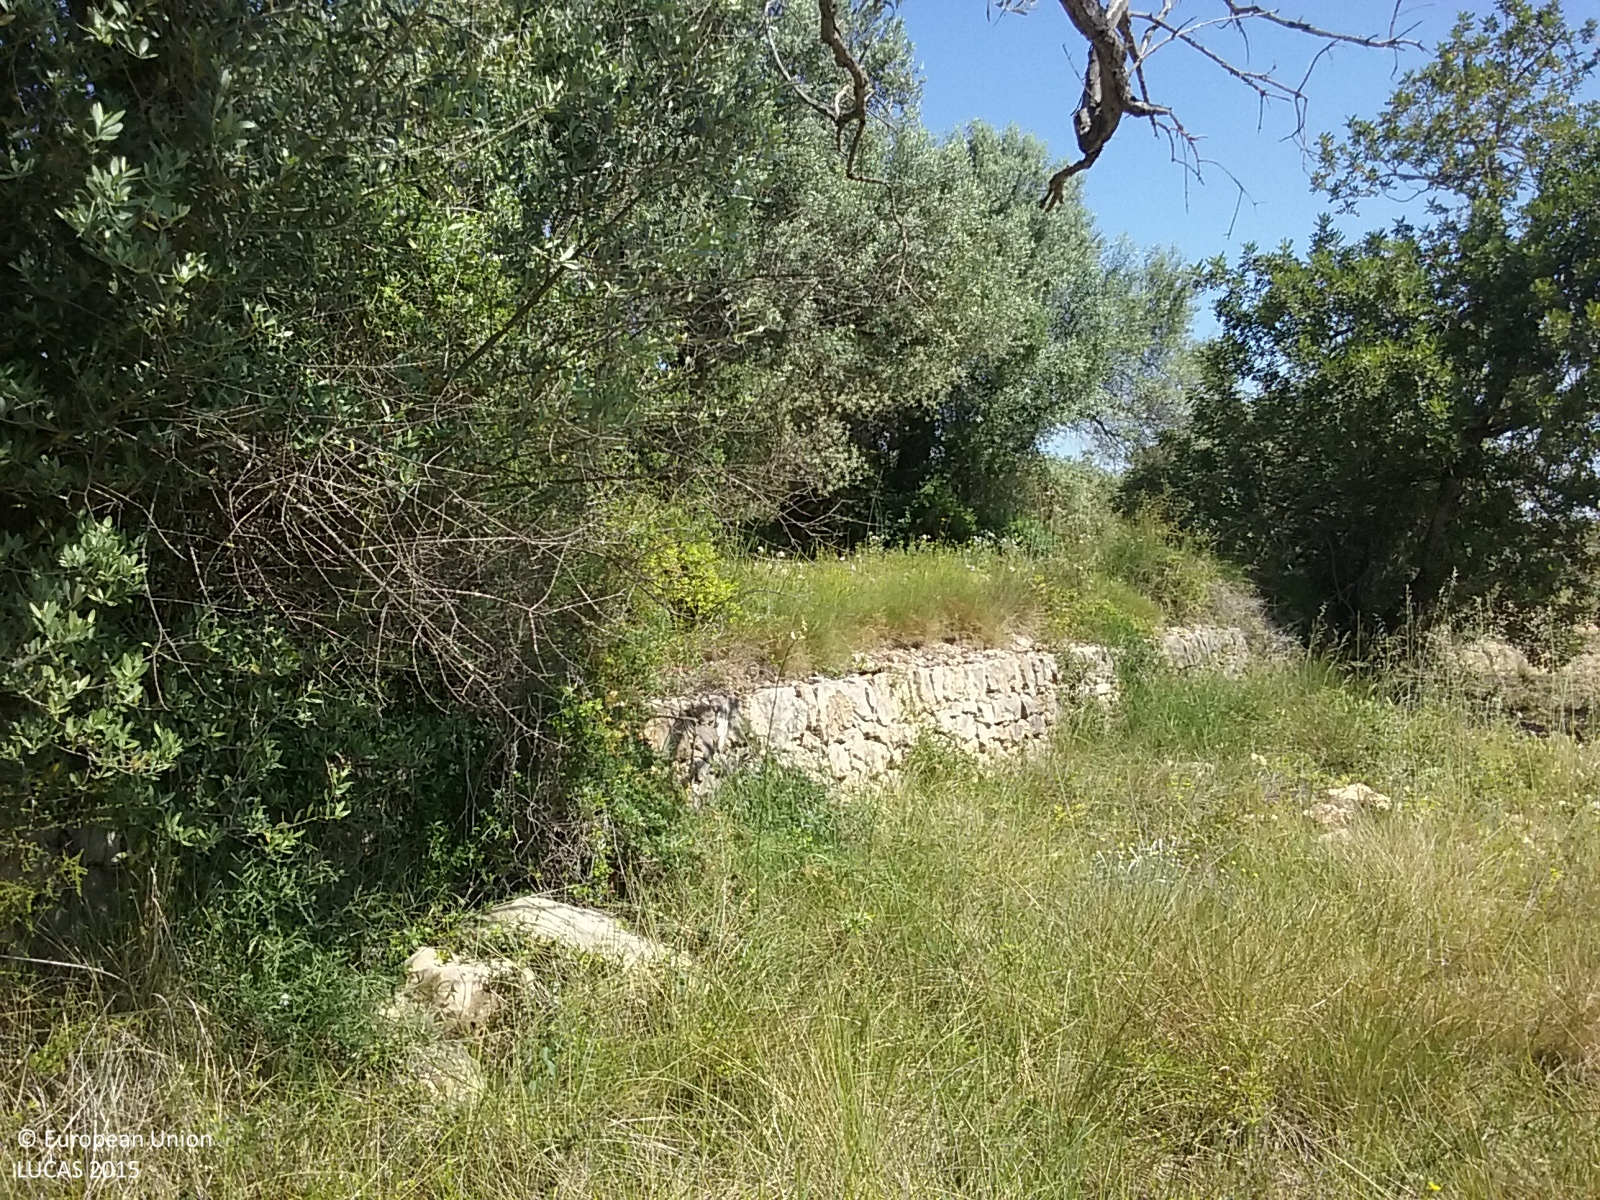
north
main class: Cropland
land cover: Olive groves
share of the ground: 25 - 50 %
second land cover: Grassland without tree/shrub cover
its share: 25 - 50 %
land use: Agriculture (excluding fallow land and kitchen gardens)
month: May
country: ES
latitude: 40.5301
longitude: 0.2797
